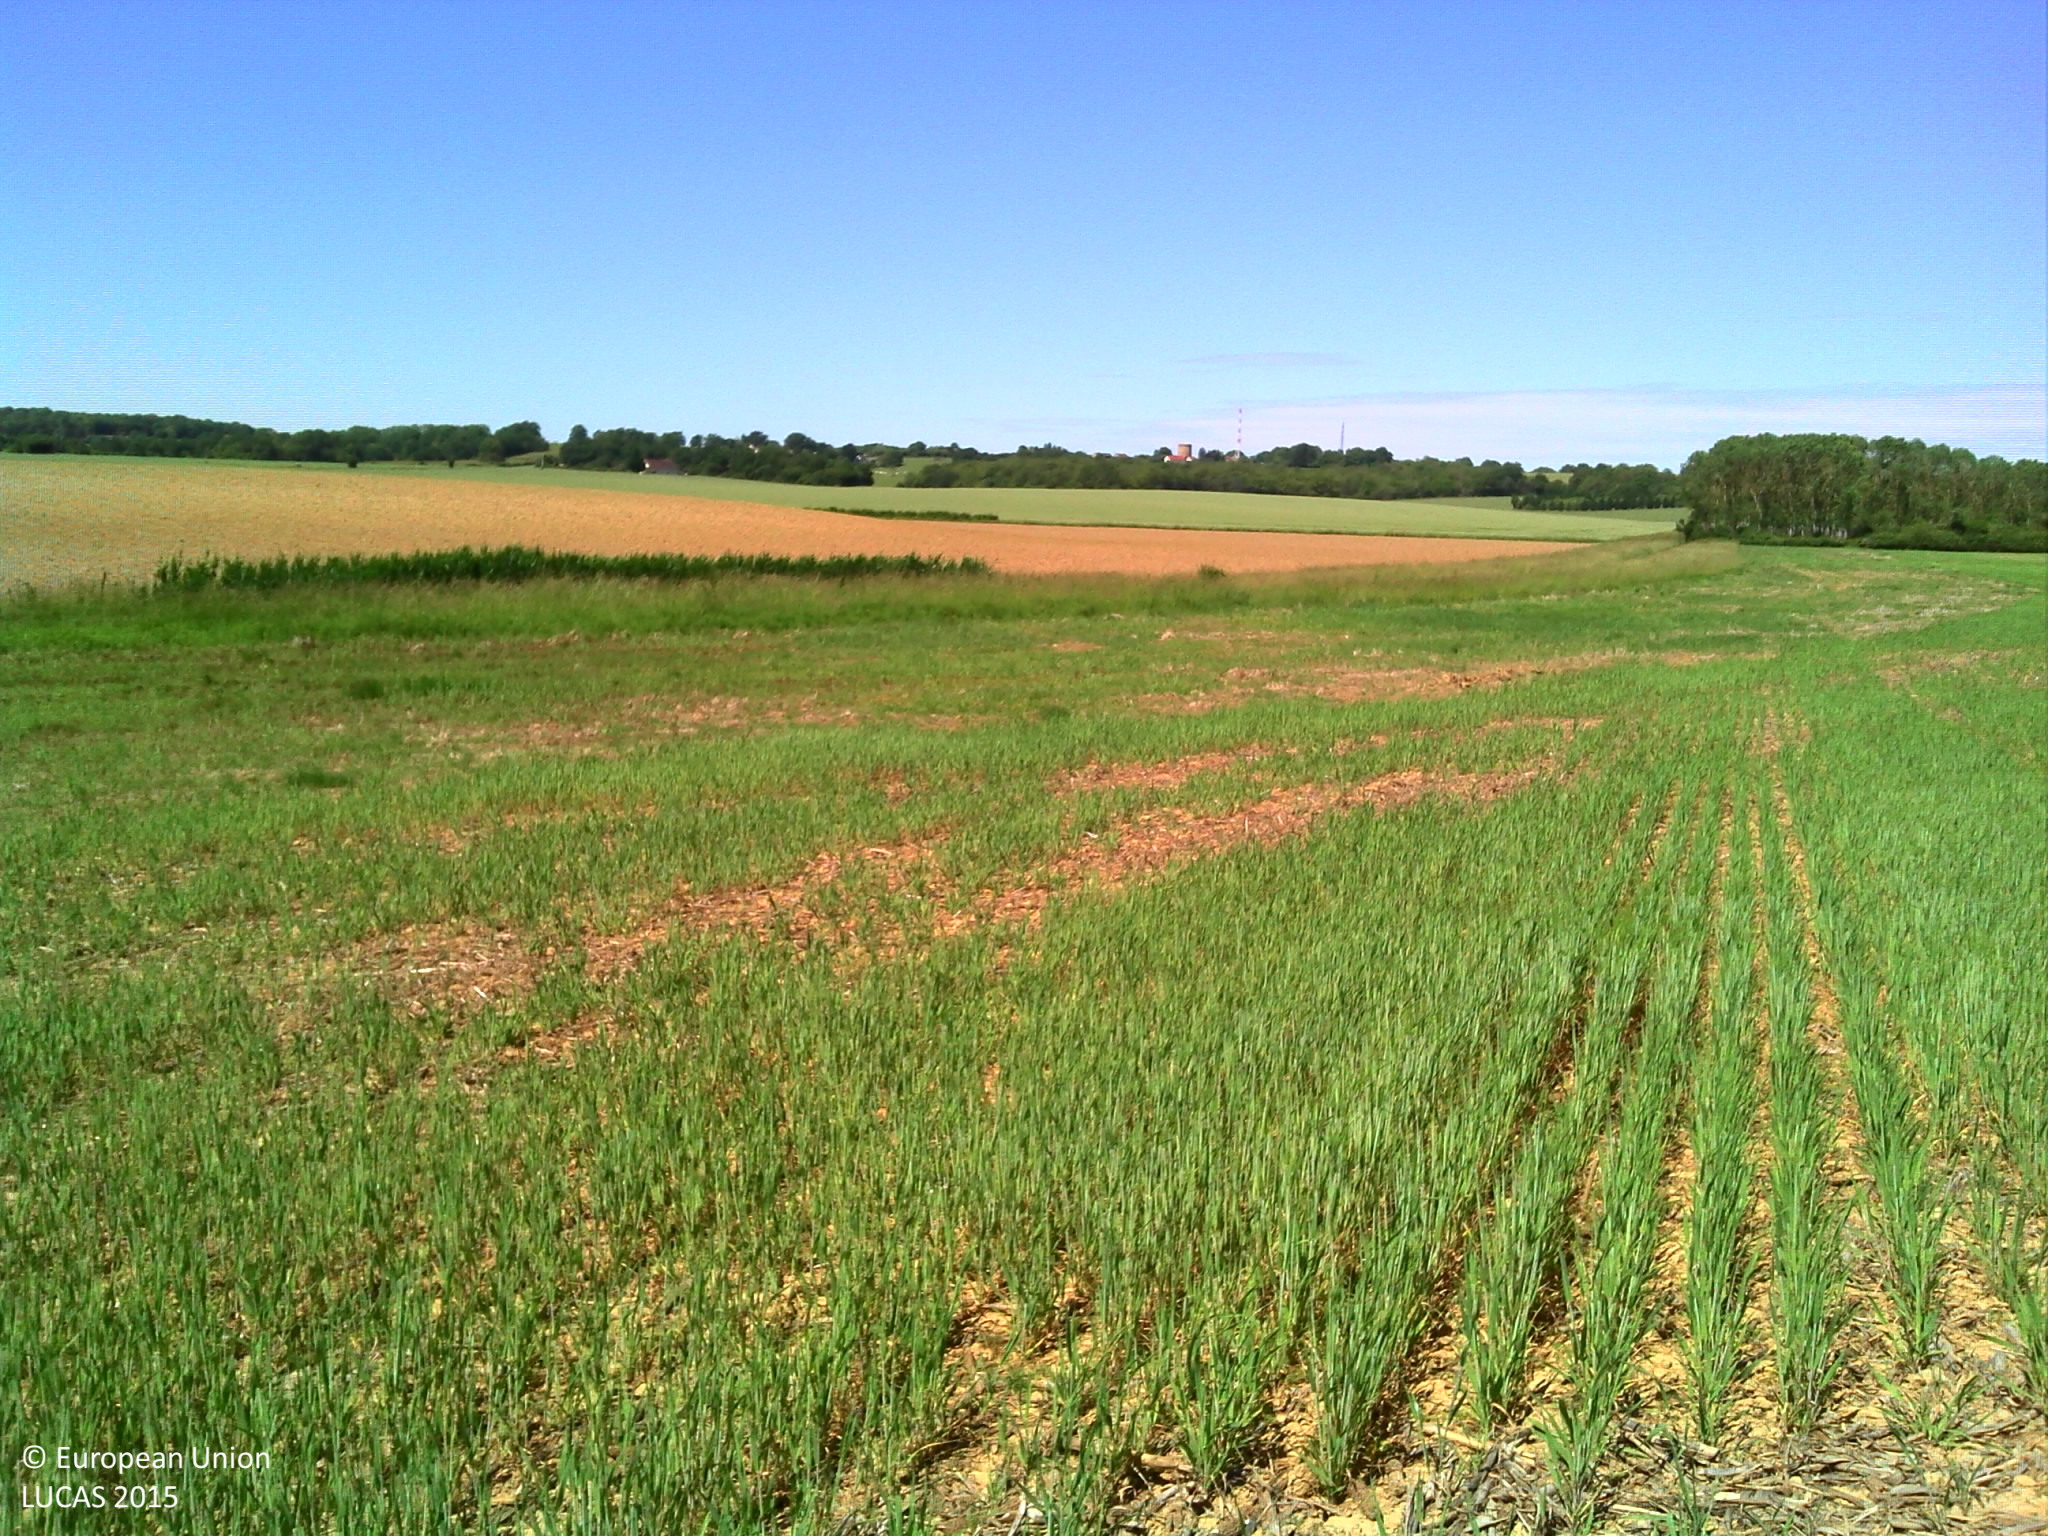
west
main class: Cropland
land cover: Barley
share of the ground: > 75 %
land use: Agriculture (excluding fallow land and kitchen gardens)
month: June
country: FR
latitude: 47.0192
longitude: 2.9042
